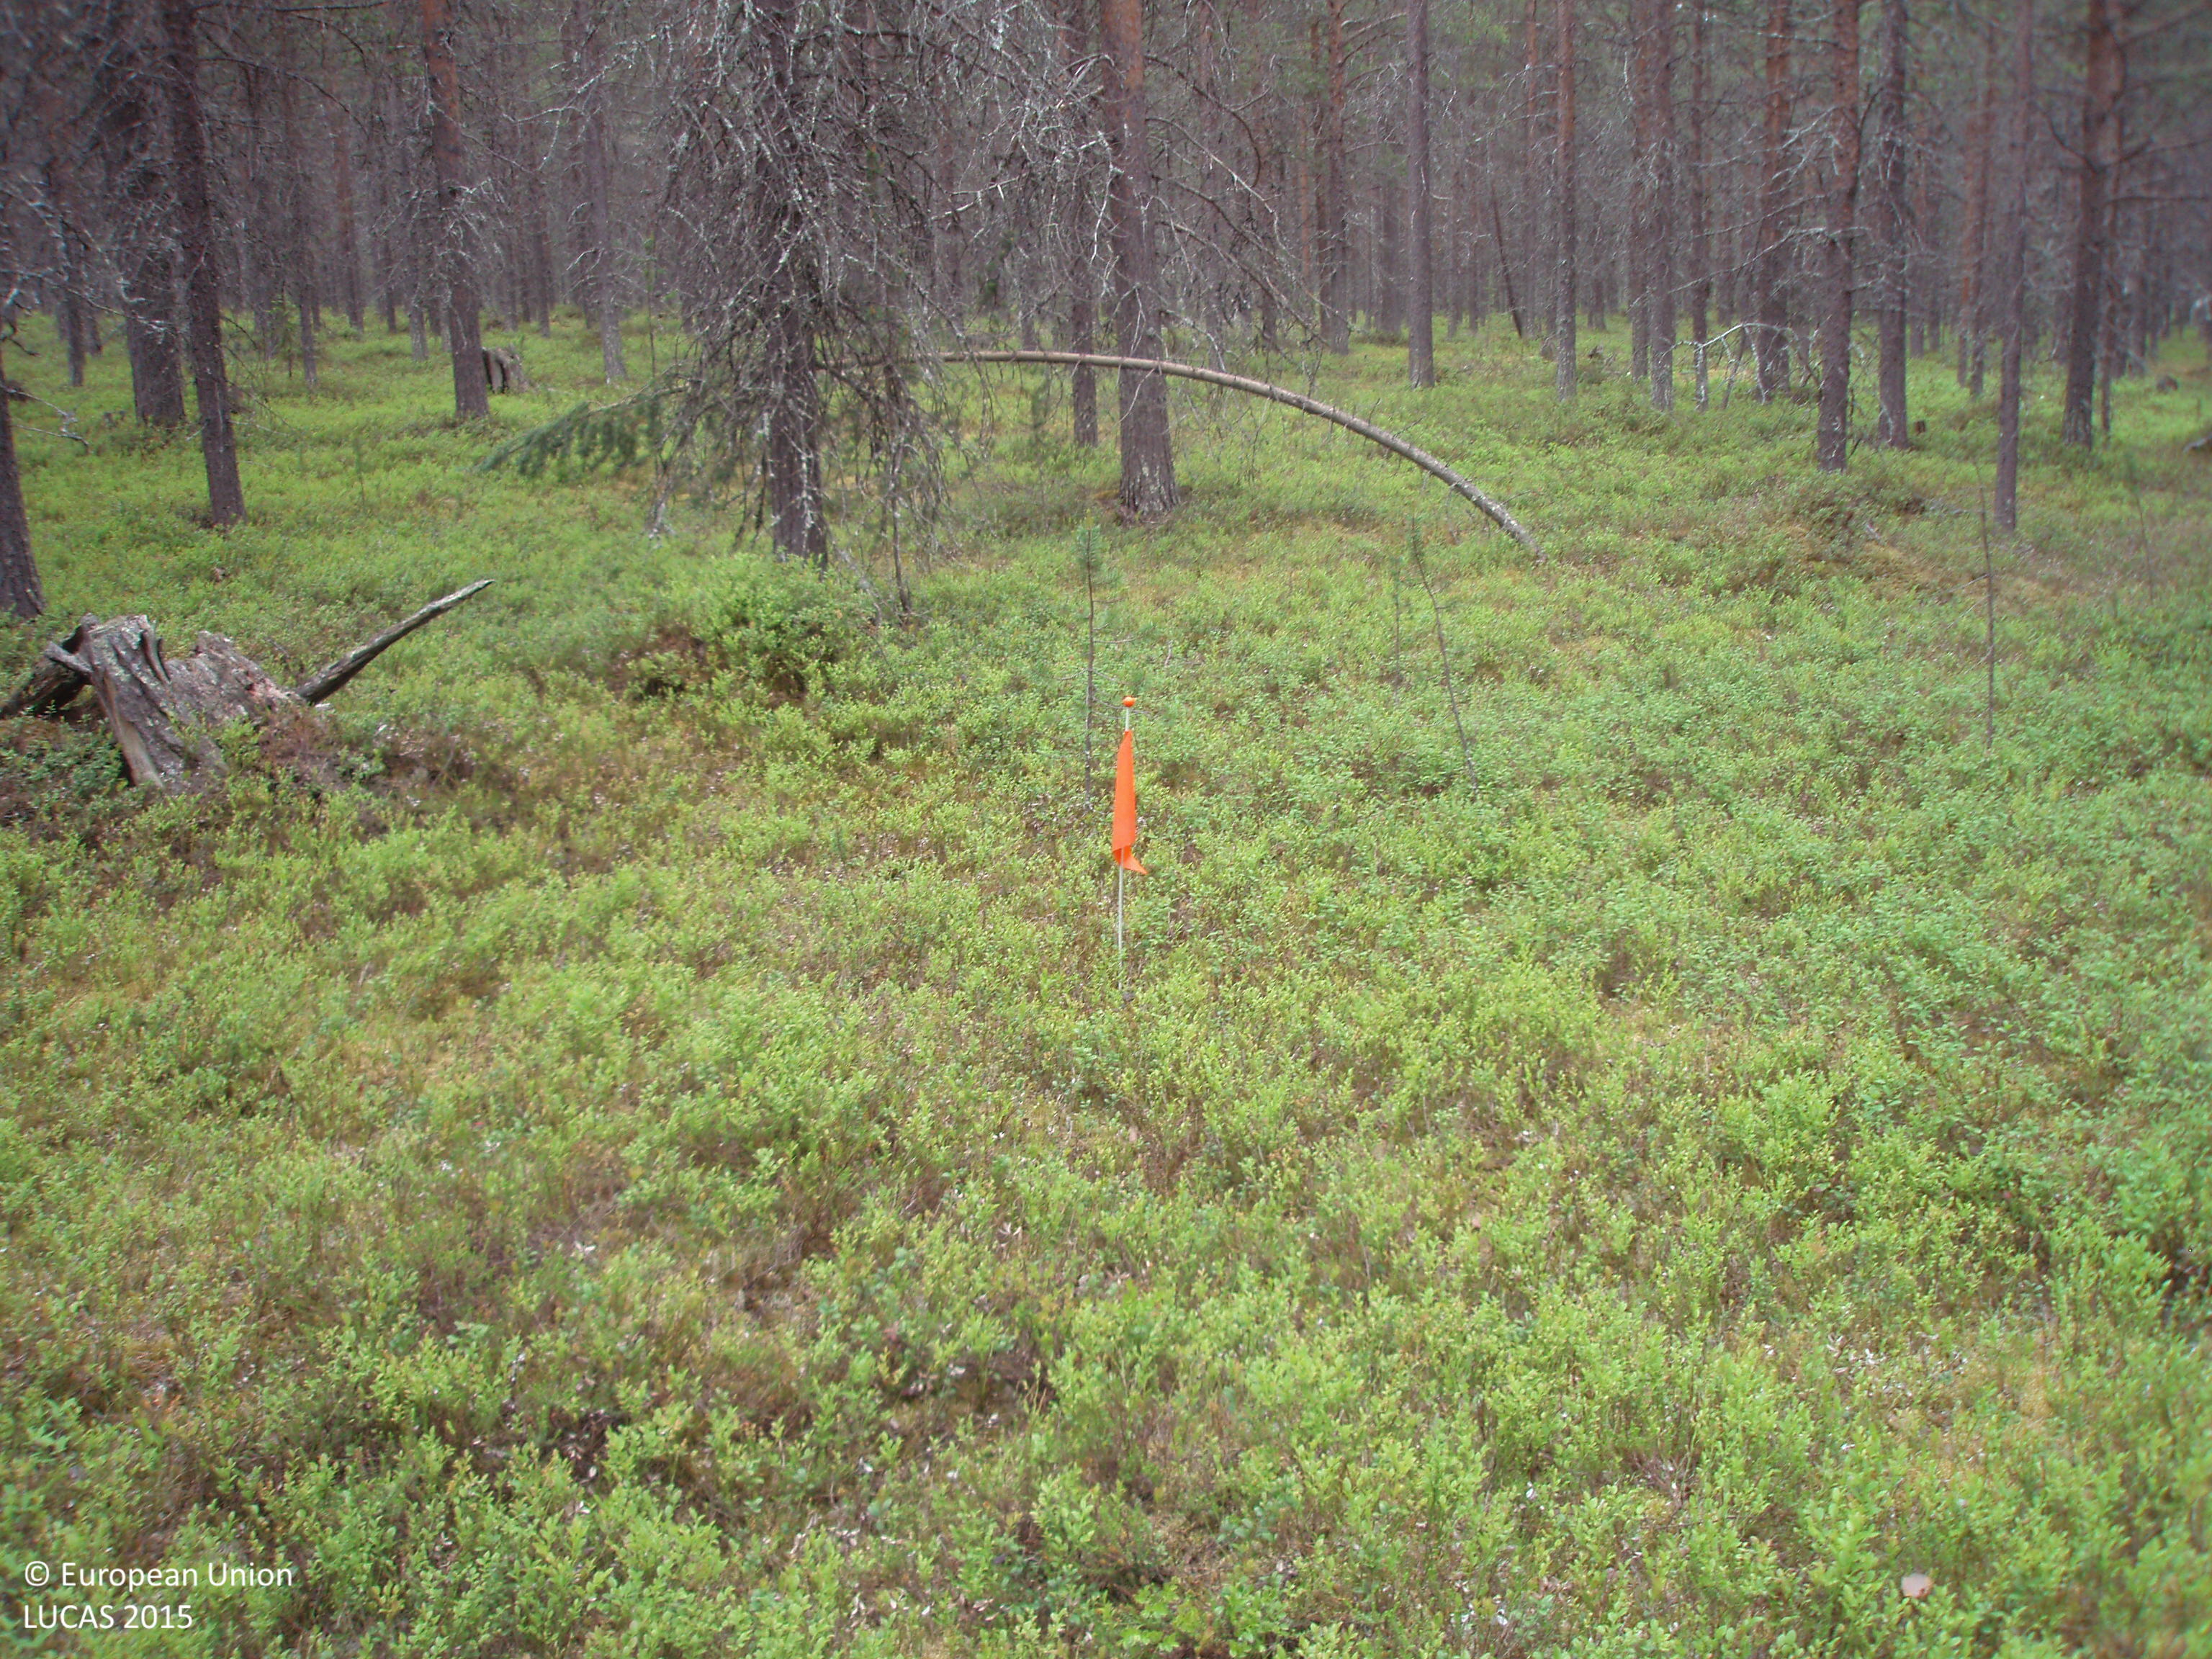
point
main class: Woodland
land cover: Pine dominated coniferous woodland
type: boreal forest
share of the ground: > 75 %
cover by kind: coniferous forest trees 80 %, shrubs 20 %
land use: Forestry
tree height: > 5 m
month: July
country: FI
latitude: 67.7029
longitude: 28.7687
